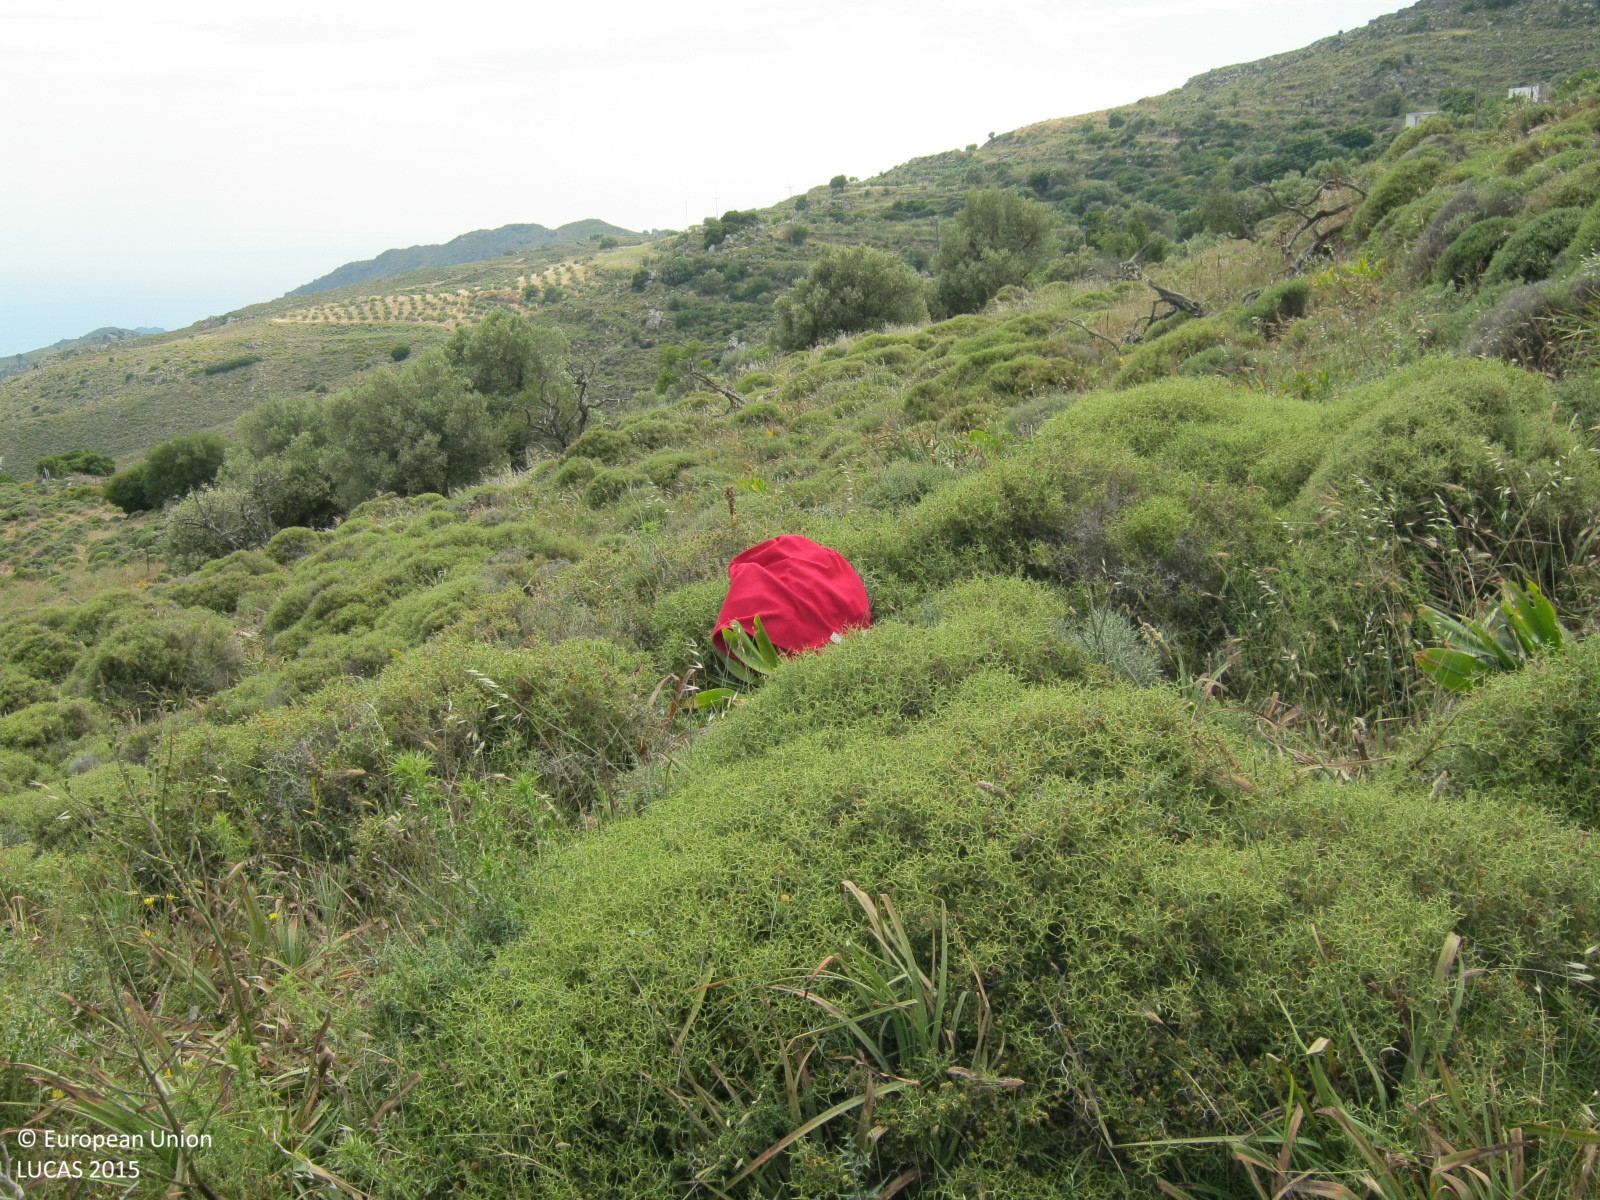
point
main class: Shrubland
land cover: Shrubland with sparse tree cover
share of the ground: > 75 %
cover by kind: shrubs 70 %, unconsolidated bare surface 20 %, broadleaved forest trees 5 %, herbaceous plants 5 %
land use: Agriculture (excluding fallow land and kitchen gardens)
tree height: < 5 m
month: June
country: GR
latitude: 35.2721
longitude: 23.7541
